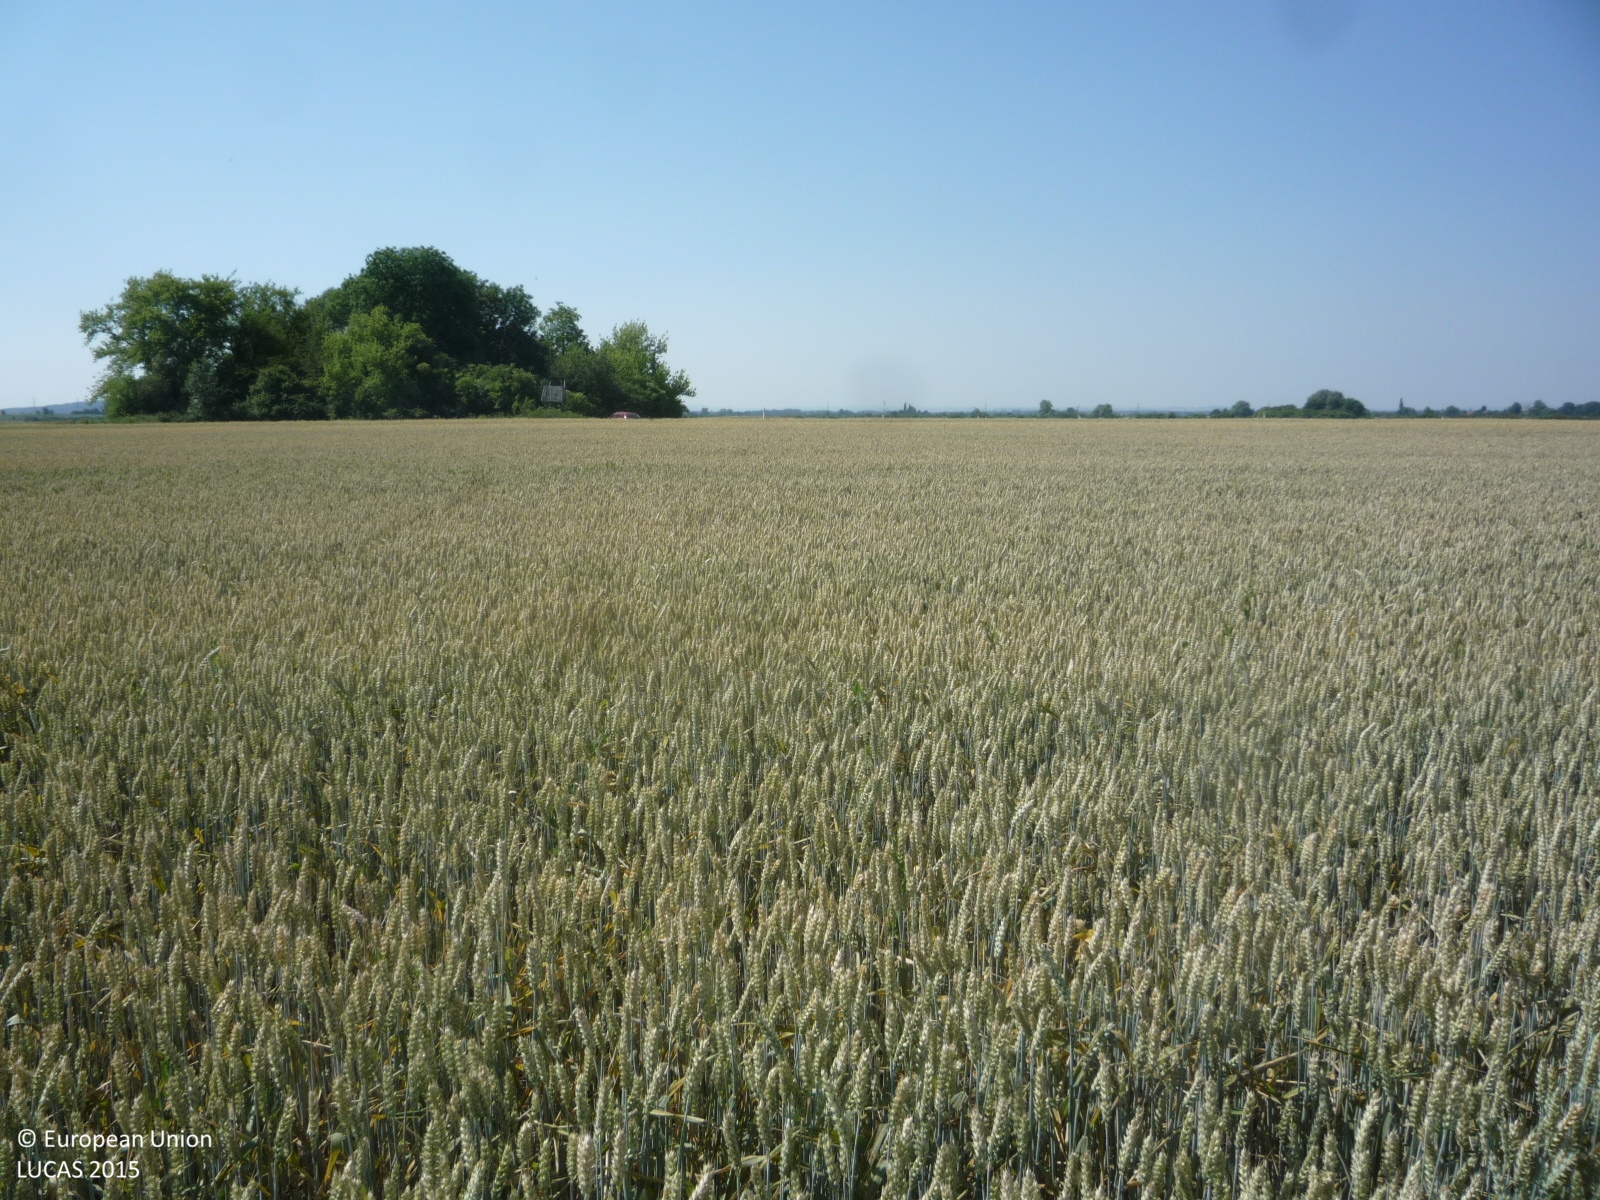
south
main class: Cropland
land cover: Common wheat
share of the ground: > 75 %
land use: Agriculture (excluding fallow land and kitchen gardens)
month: July
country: CZ
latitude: 50.2097
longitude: 15.2019
